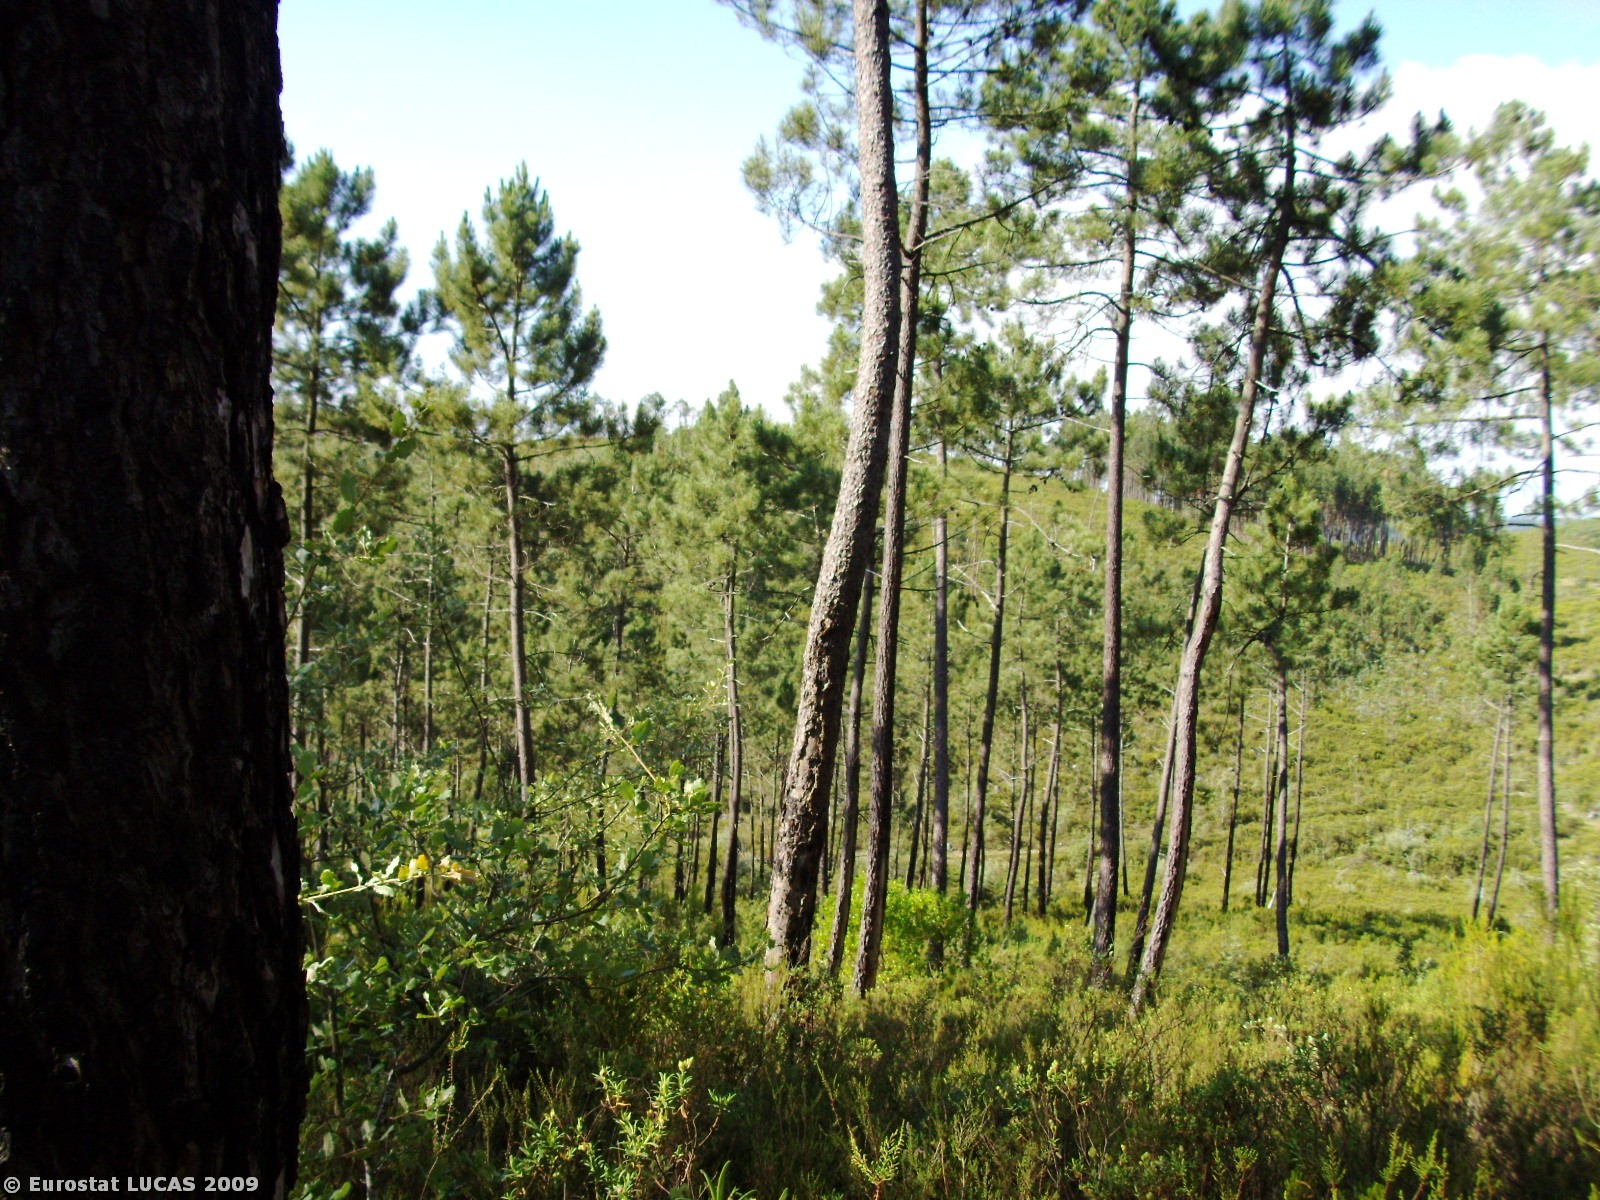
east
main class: Woodland
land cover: Coniferous woodland
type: coniferous forest of the mediterranean region
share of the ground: 50 - 75 %
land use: Forestry
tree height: > 5 m
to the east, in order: Coniferous woodland; Shrubland with sparse tree cover; Tracks; Coniferous woodland; Rivers and streams; Coniferous woodland; Tracks; Broadleaved woodland
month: June
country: PT
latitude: 39.8134
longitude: -8.4521
